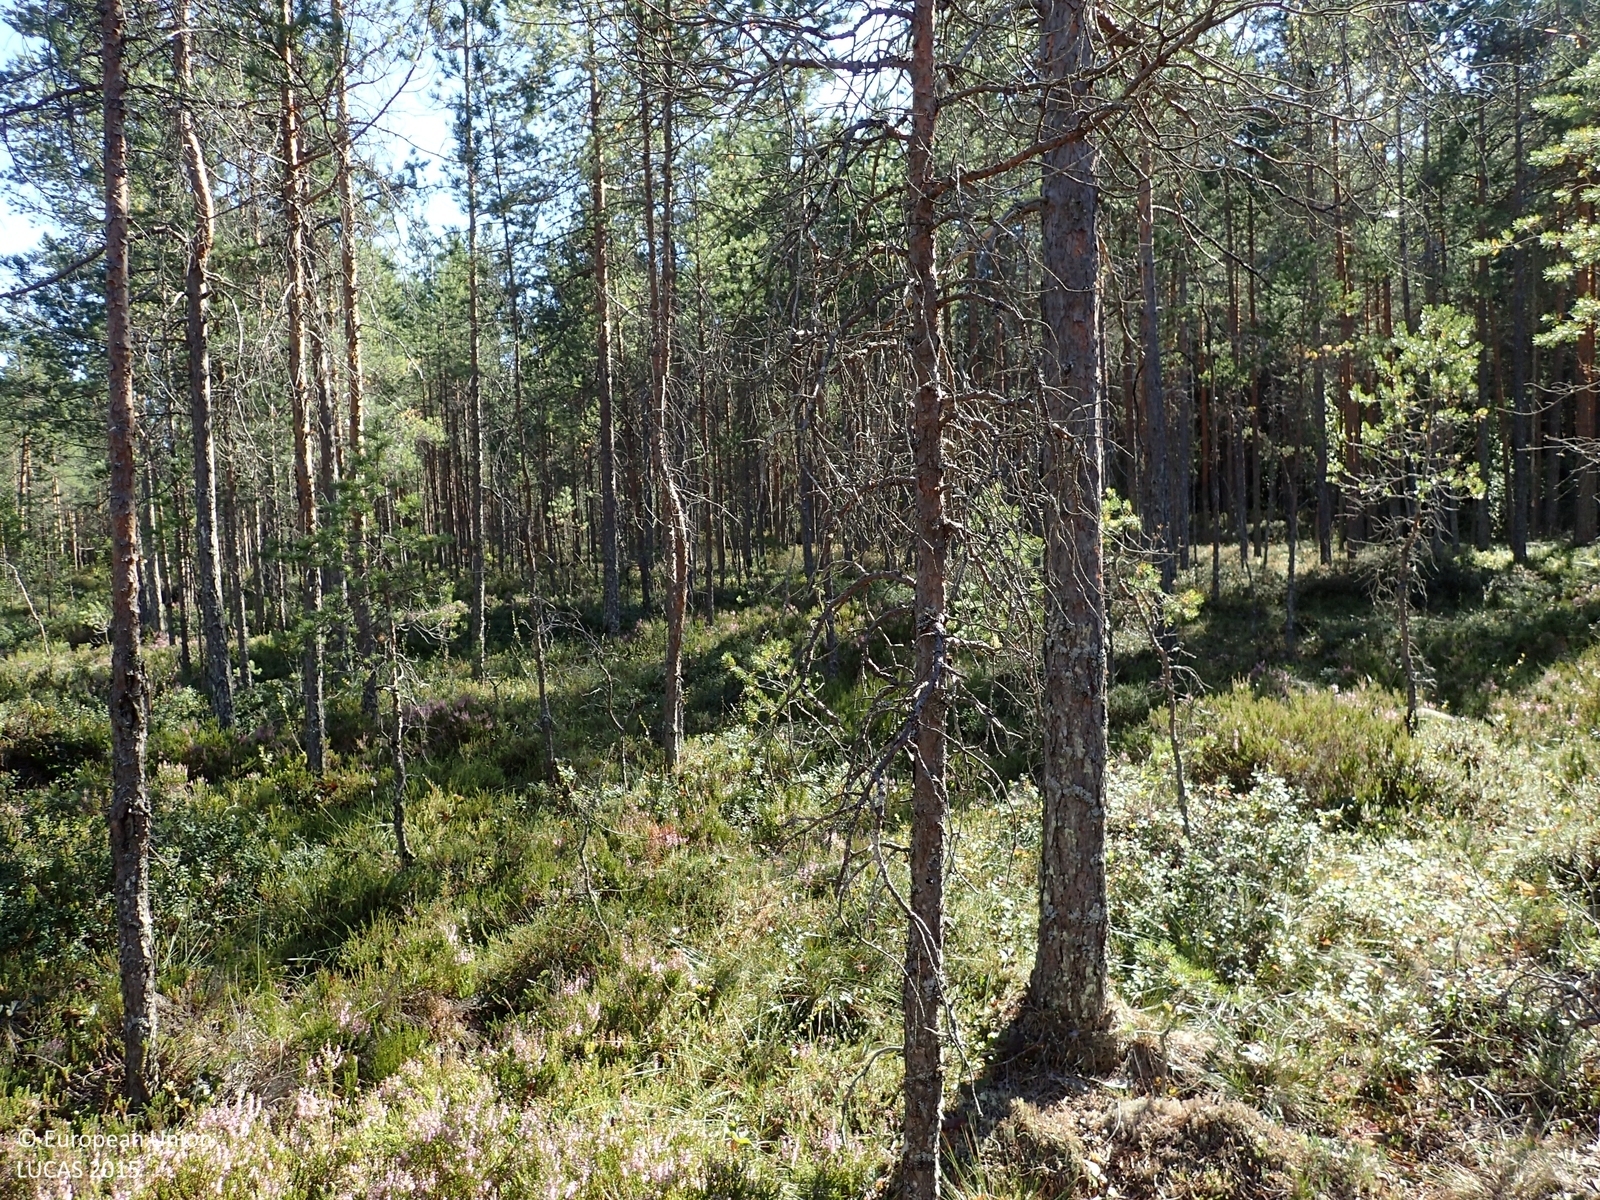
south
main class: Woodland
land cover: Pine dominated coniferous woodland
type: boreal forest
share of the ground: 25 - 50 %
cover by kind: shrubs 55 %, coniferous forest trees 45 %
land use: Forestry
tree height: < 5 m
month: August
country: FI
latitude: 62.6206
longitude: 22.7075
